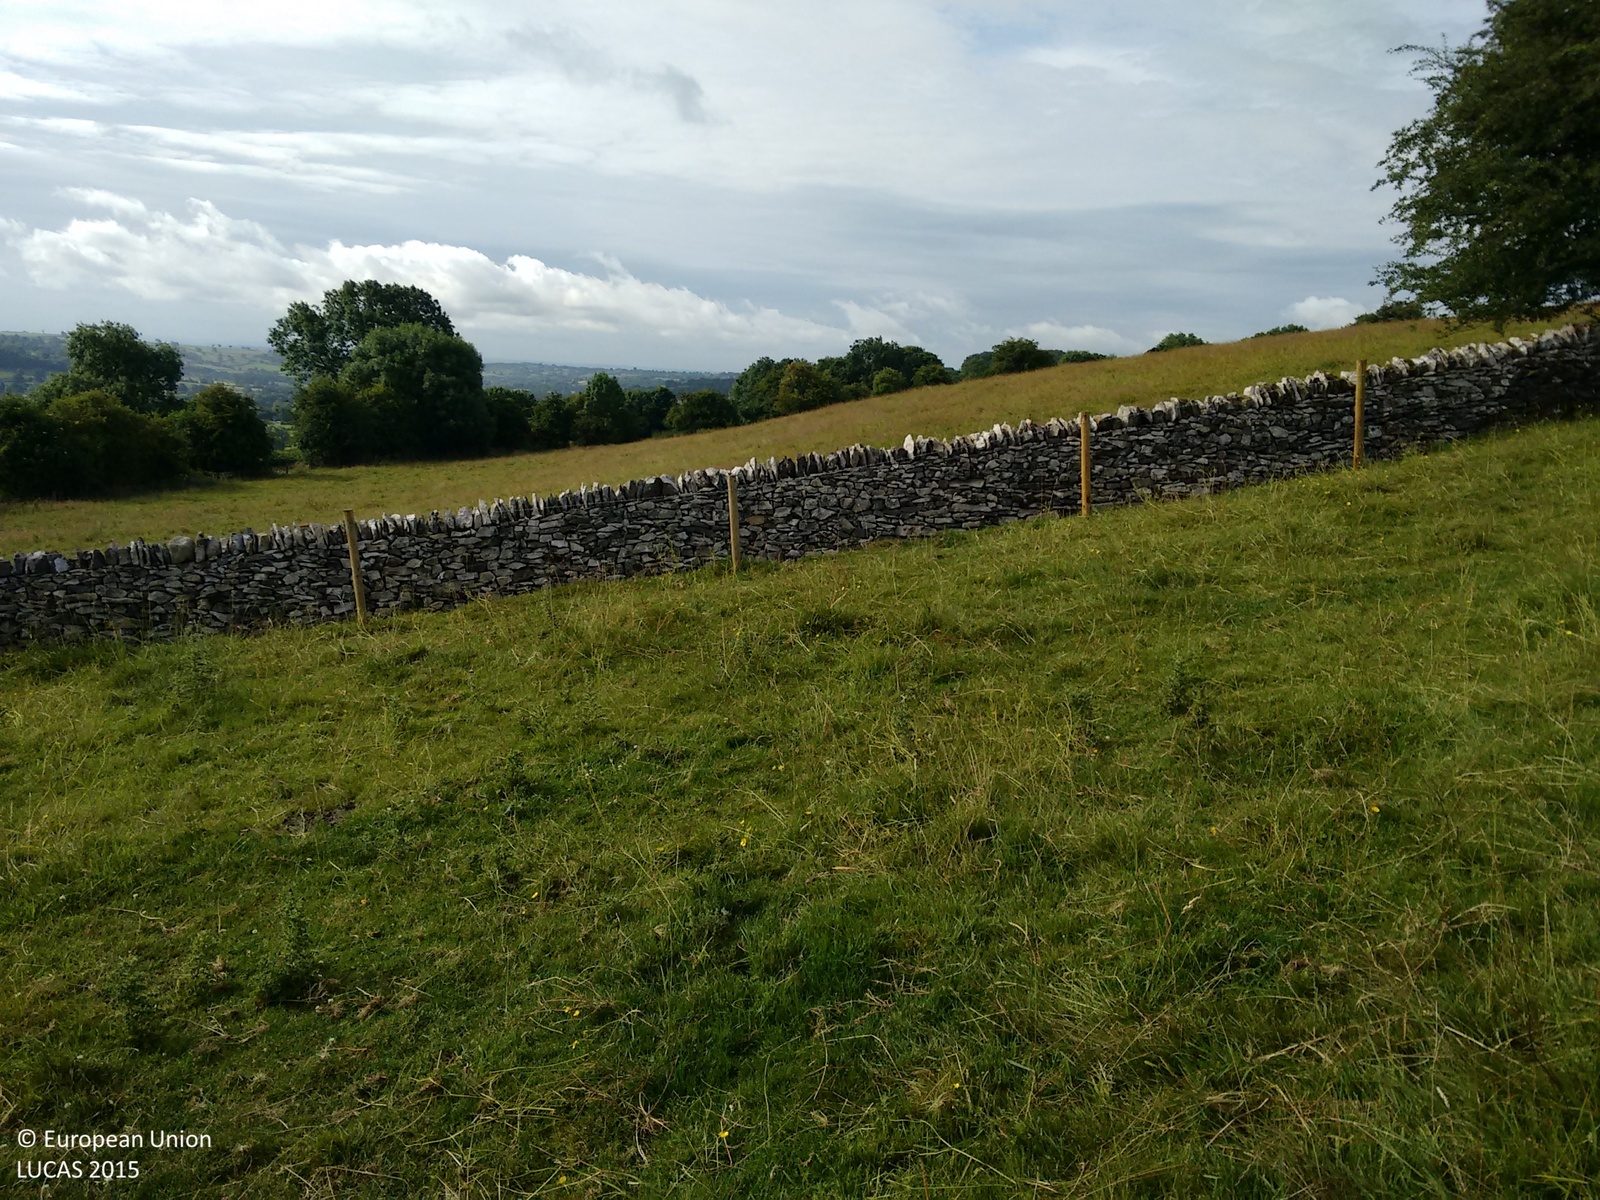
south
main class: Grassland
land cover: Grassland without tree/shrub cover
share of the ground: > 75 %
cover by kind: herbaceous plants 100 %
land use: Agriculture (excluding fallow land and kitchen gardens)
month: July
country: GB
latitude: 53.0793
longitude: -1.5911
